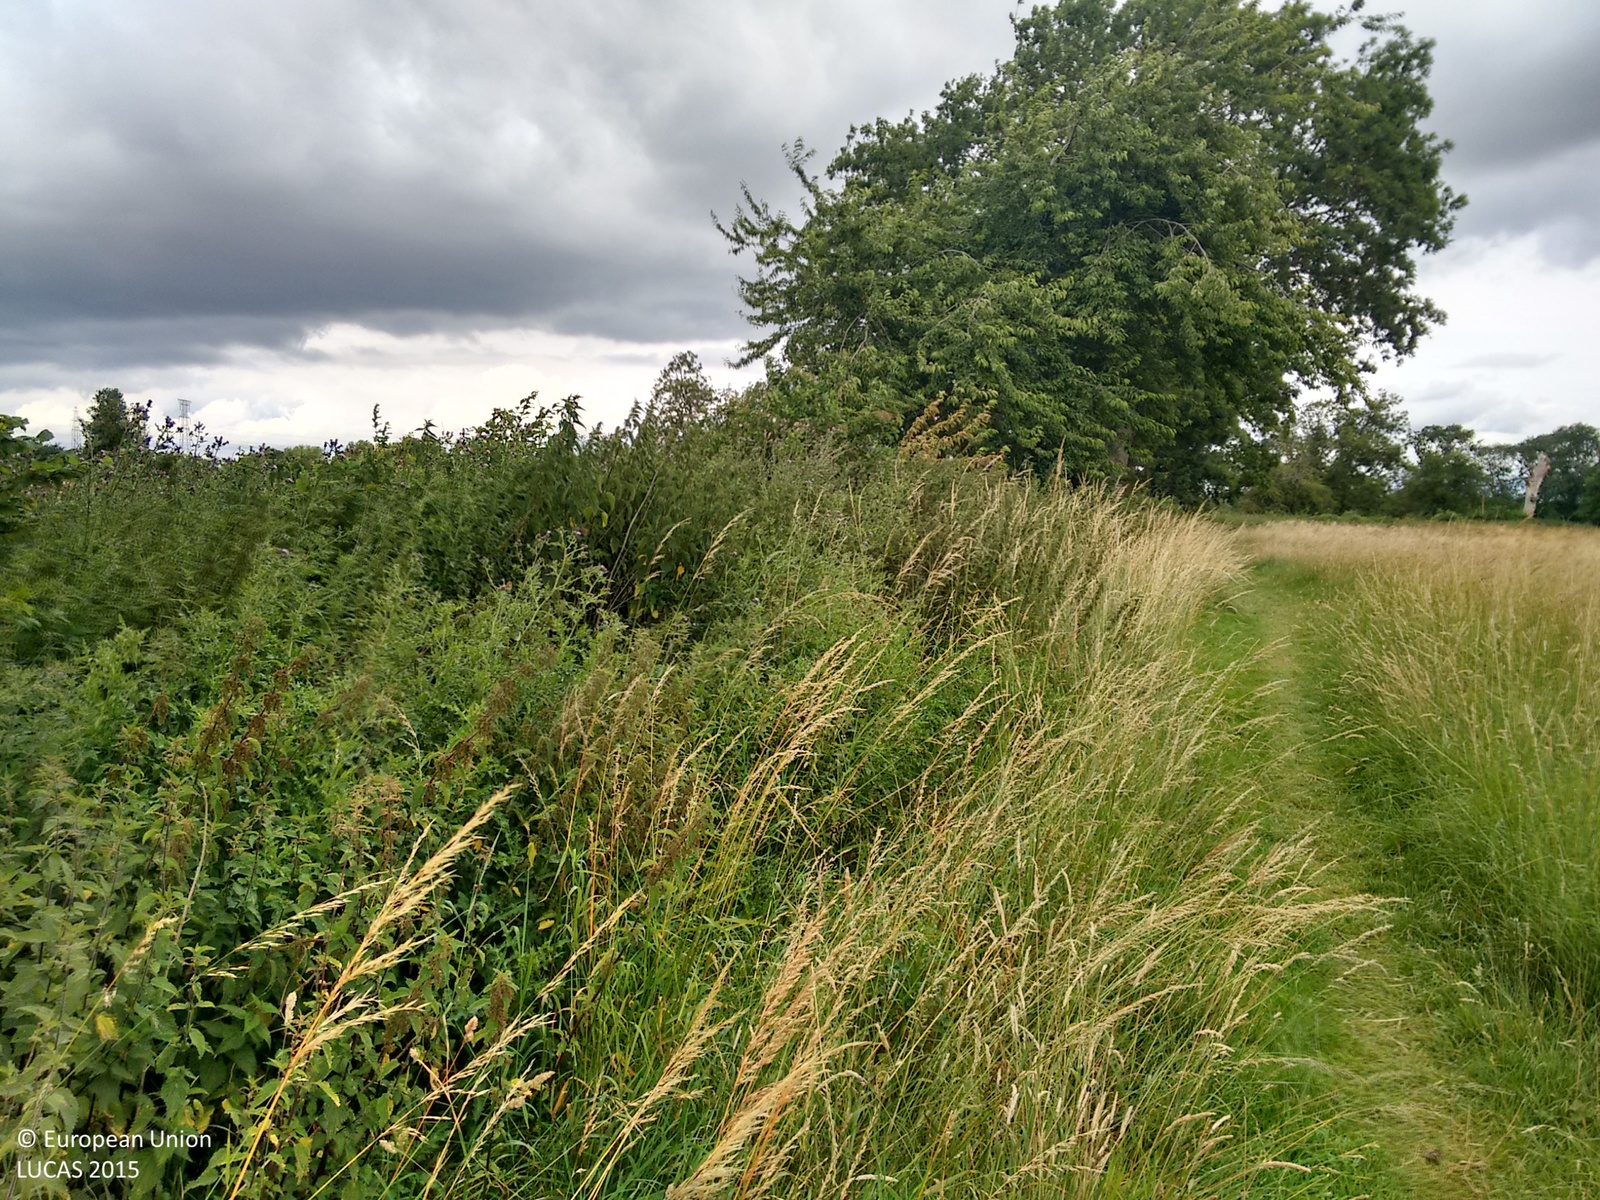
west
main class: Grassland
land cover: Grassland without tree/shrub cover
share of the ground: > 75 %
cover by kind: herbaceous plants 100 %
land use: Agriculture (excluding fallow land and kitchen gardens)
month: July
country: GB
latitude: 53.0572
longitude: -0.8593
